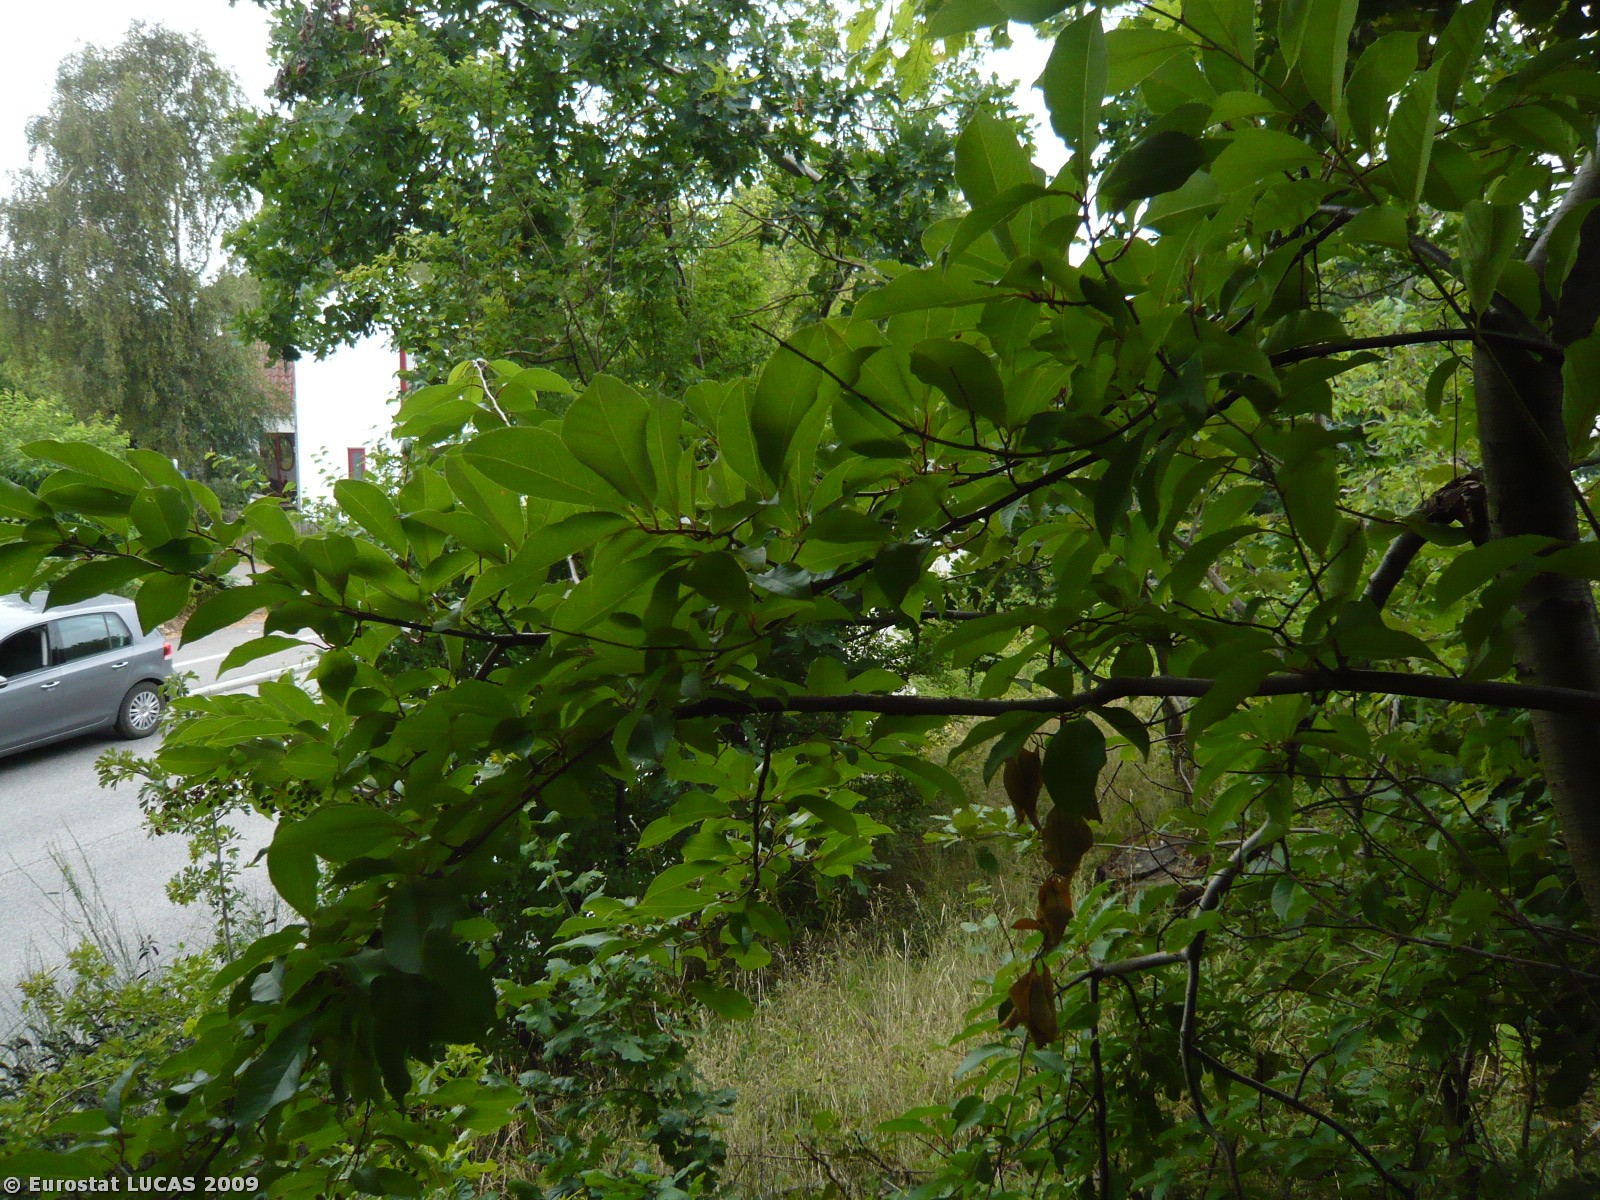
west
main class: Woodland
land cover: Broadleaved woodland
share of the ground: > 75 %
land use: Residential
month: August
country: DK
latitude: 56.0975
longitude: 12.1680
